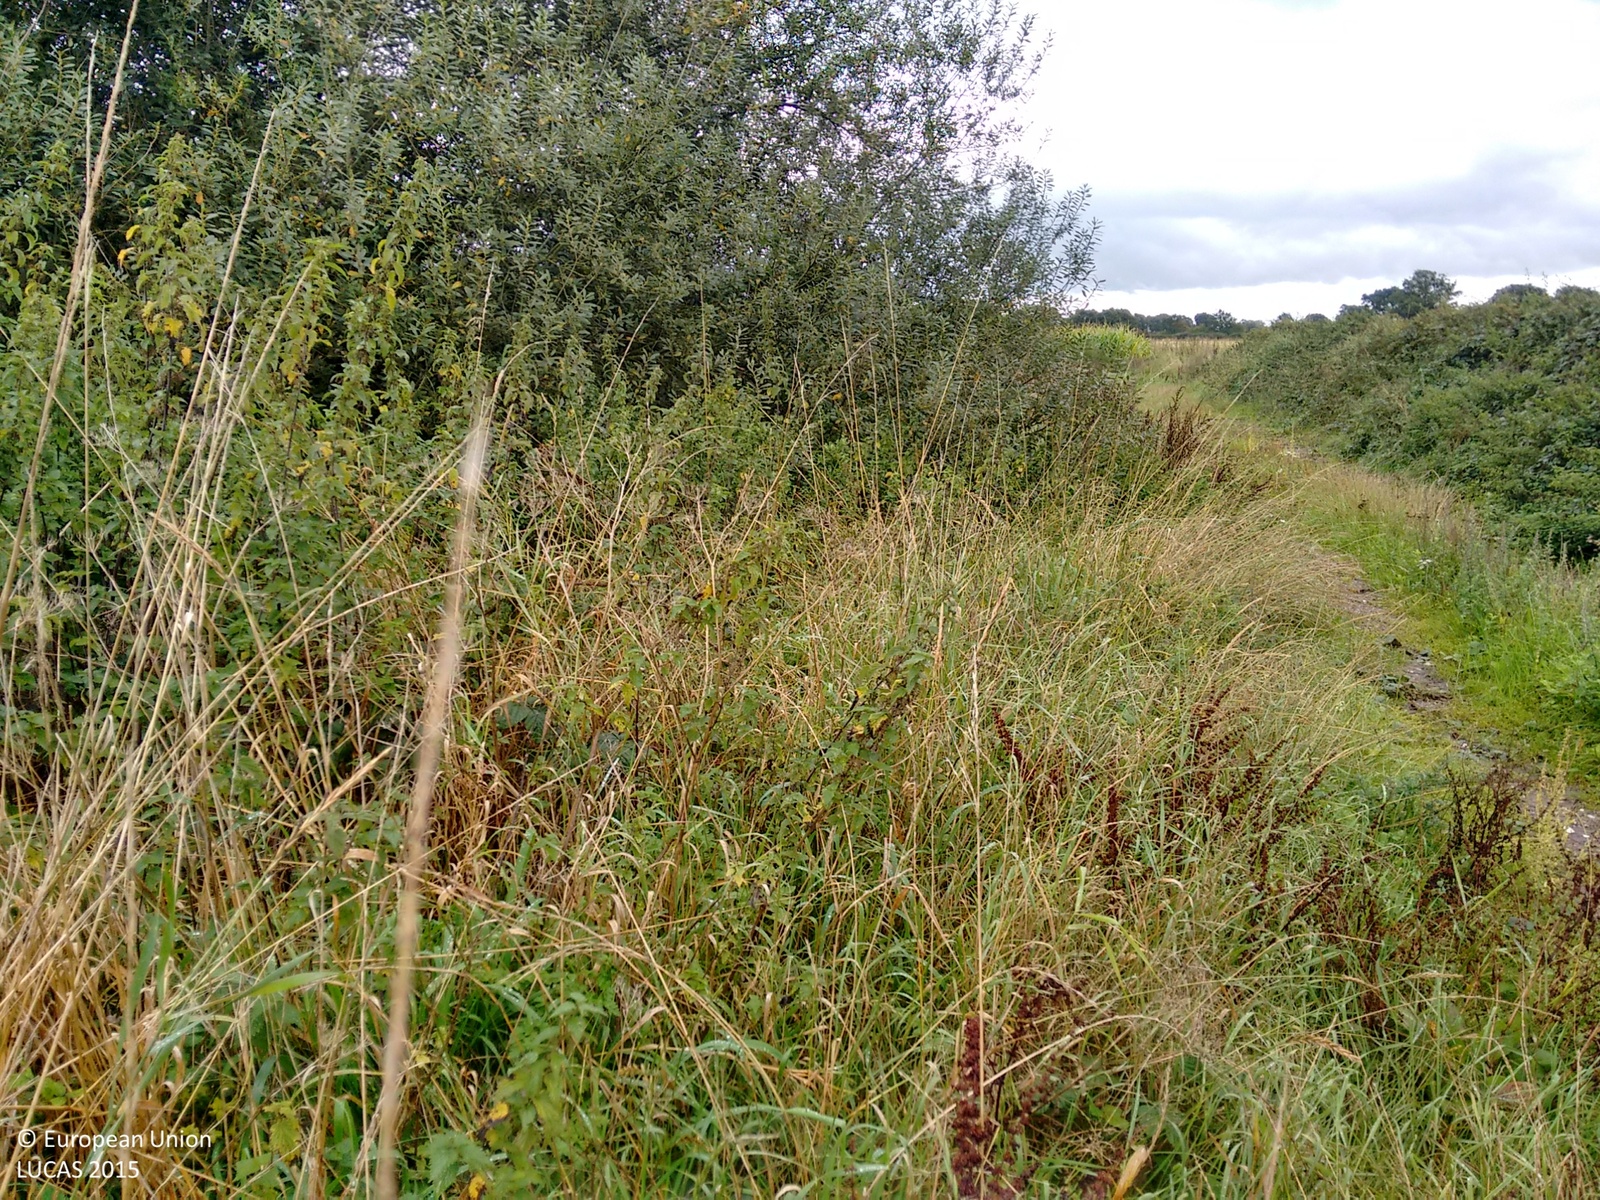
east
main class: Grassland
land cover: Grassland without tree/shrub cover
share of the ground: > 75 %
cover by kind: herbaceous plants 100 %
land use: Agriculture (excluding fallow land and kitchen gardens)
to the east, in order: Grassland without tree/shrub cover; Fences; Broadleaved woodland; Fences; Grassland without tree/shrub cover
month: September
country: GB
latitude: 52.7495
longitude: -1.8034
